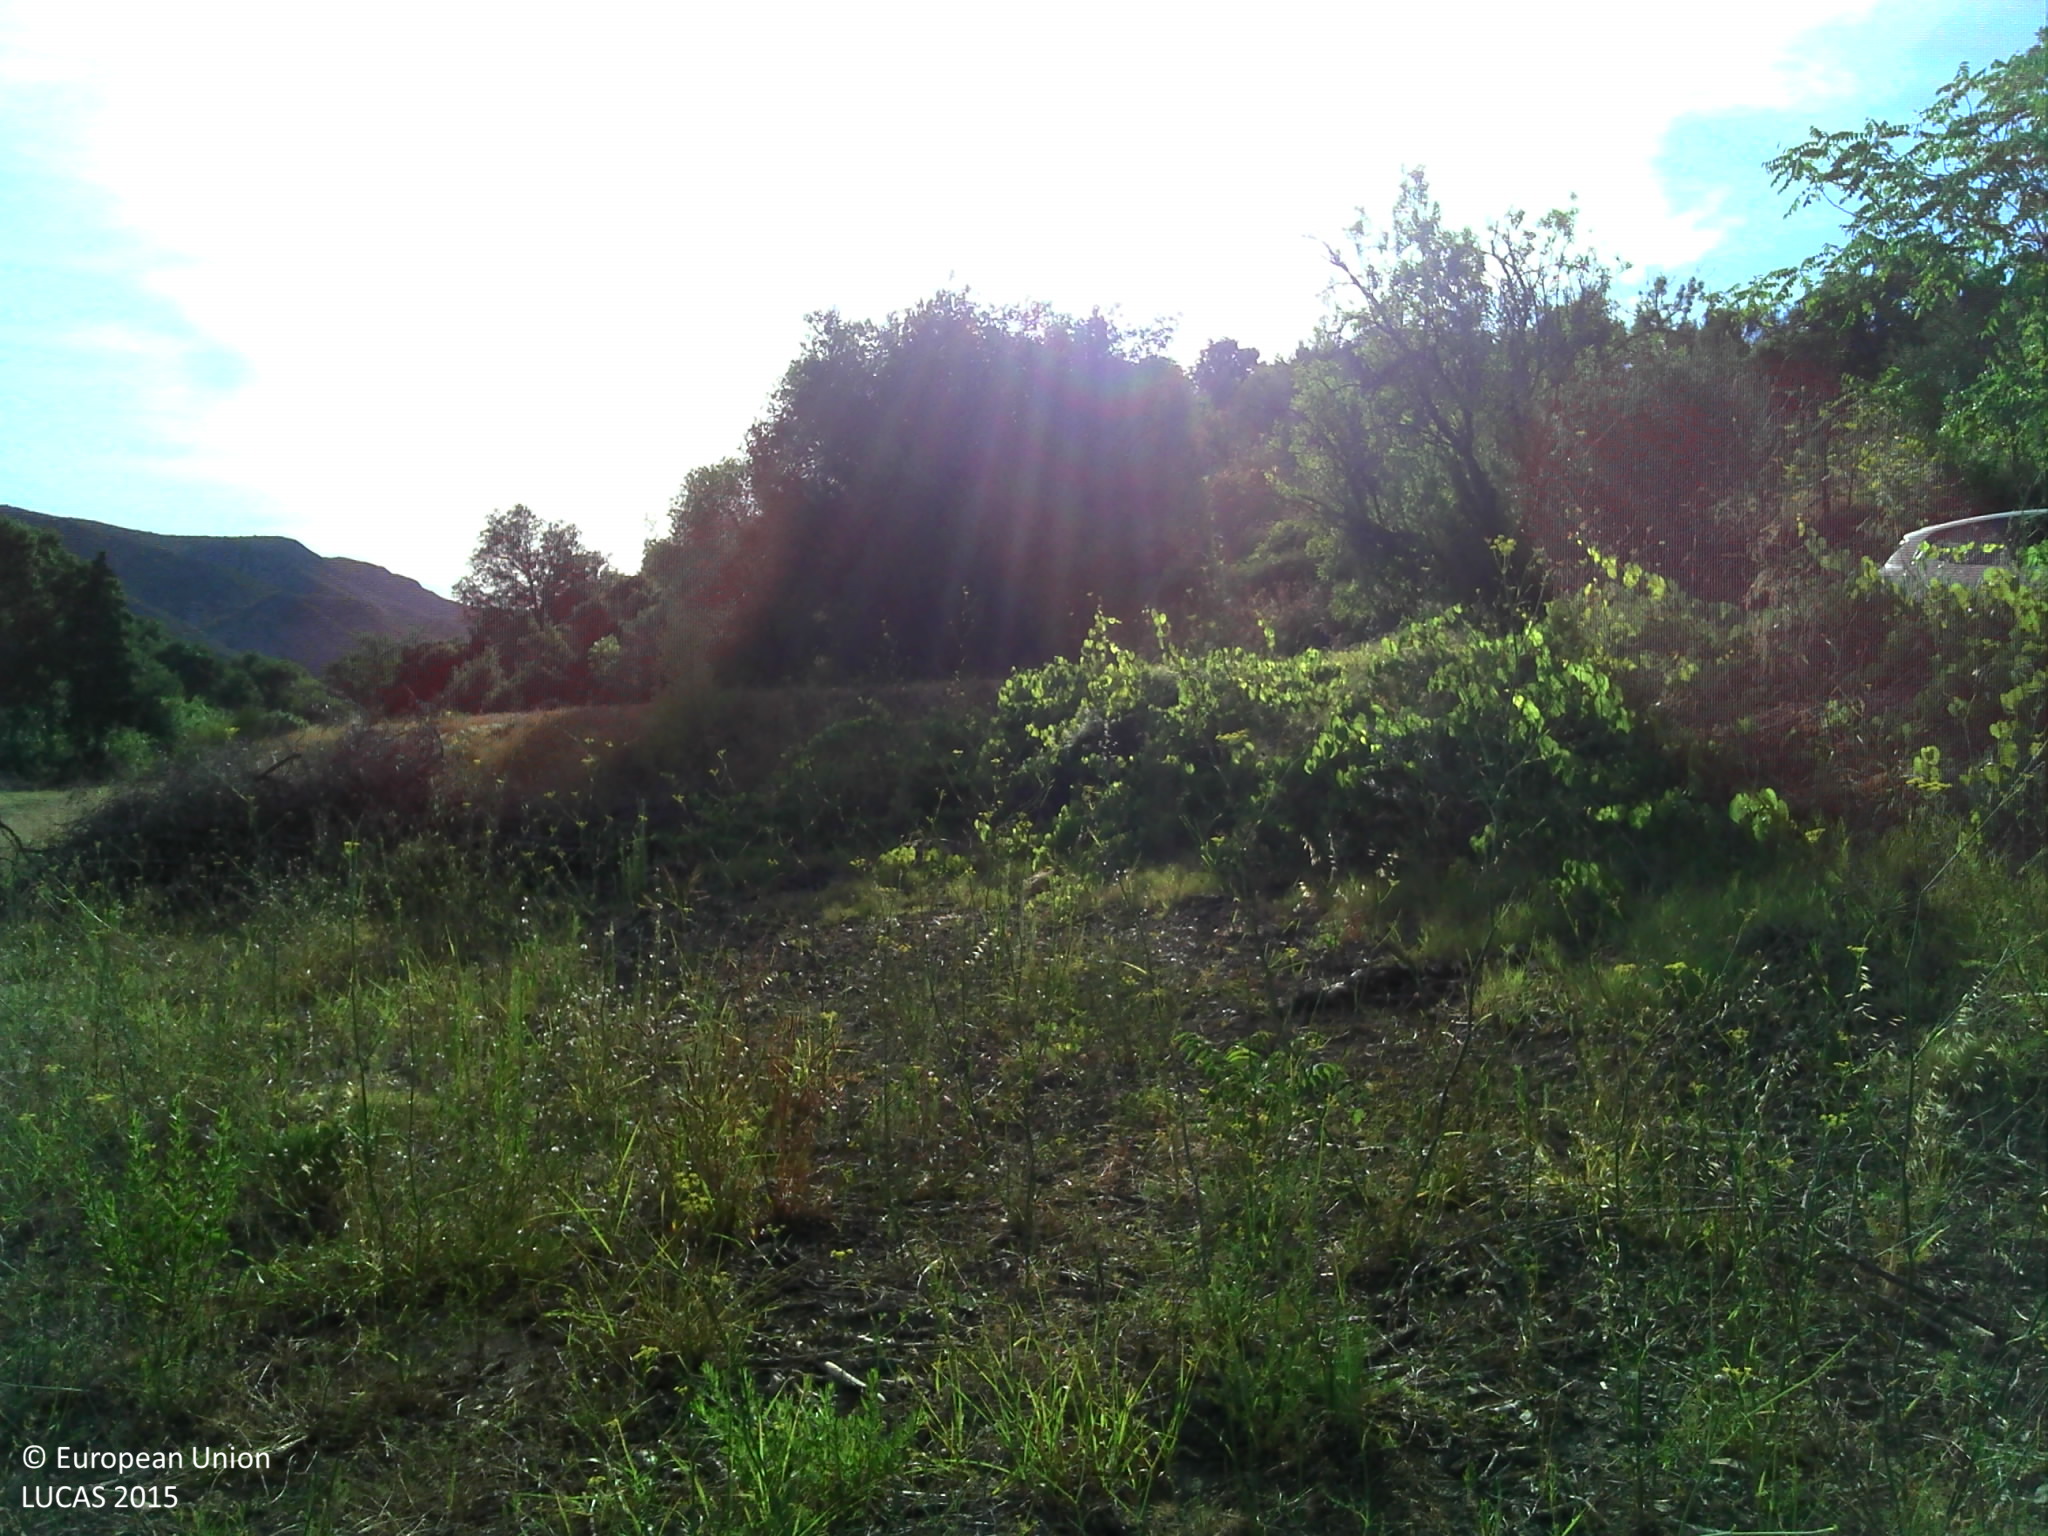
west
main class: Grassland
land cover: Spontaneously vegetated surfaces
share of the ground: > 75 %
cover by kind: unconsolidated bare surface 70 %, herbaceous plants 30 %
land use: Fallow land
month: July
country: FR
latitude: 42.7756
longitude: 2.7634
